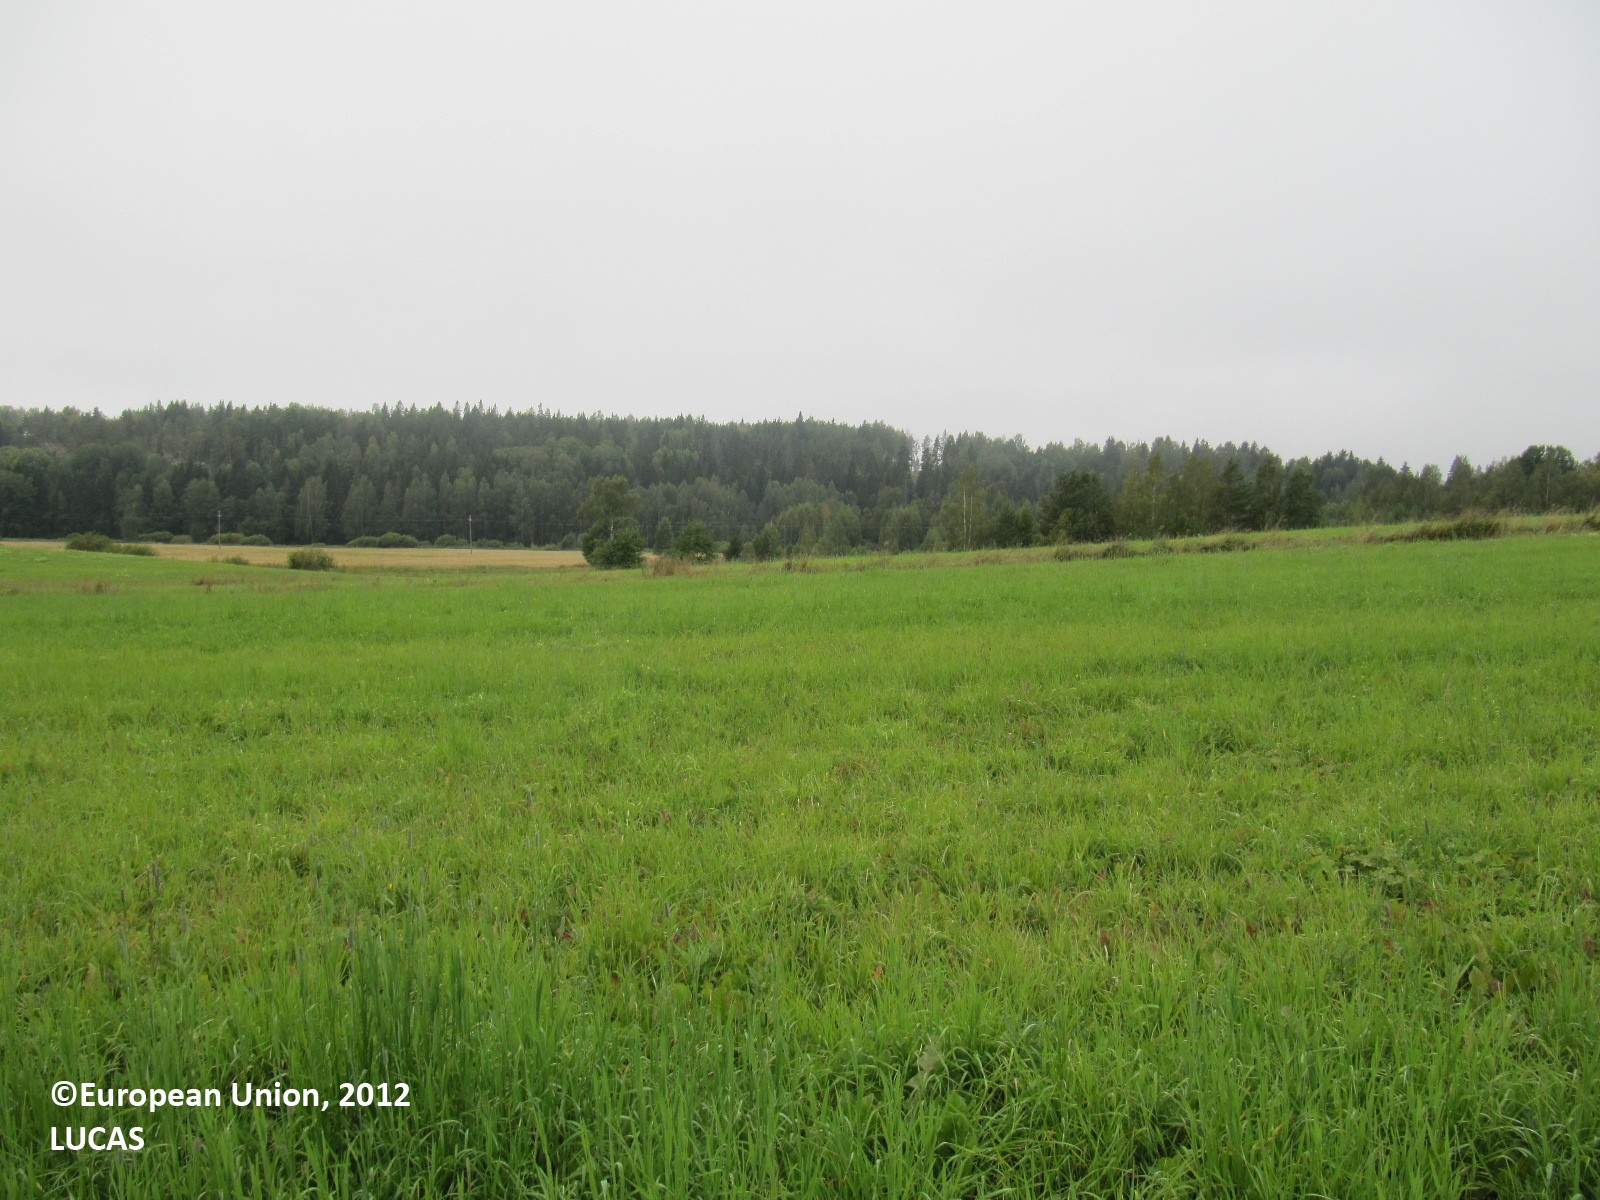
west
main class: Cropland
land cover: Temporary grasslands
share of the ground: > 75 %
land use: Agriculture (excluding fallow land and kitchen gardens)
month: August
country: FI
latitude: 60.2725
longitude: 24.2957
